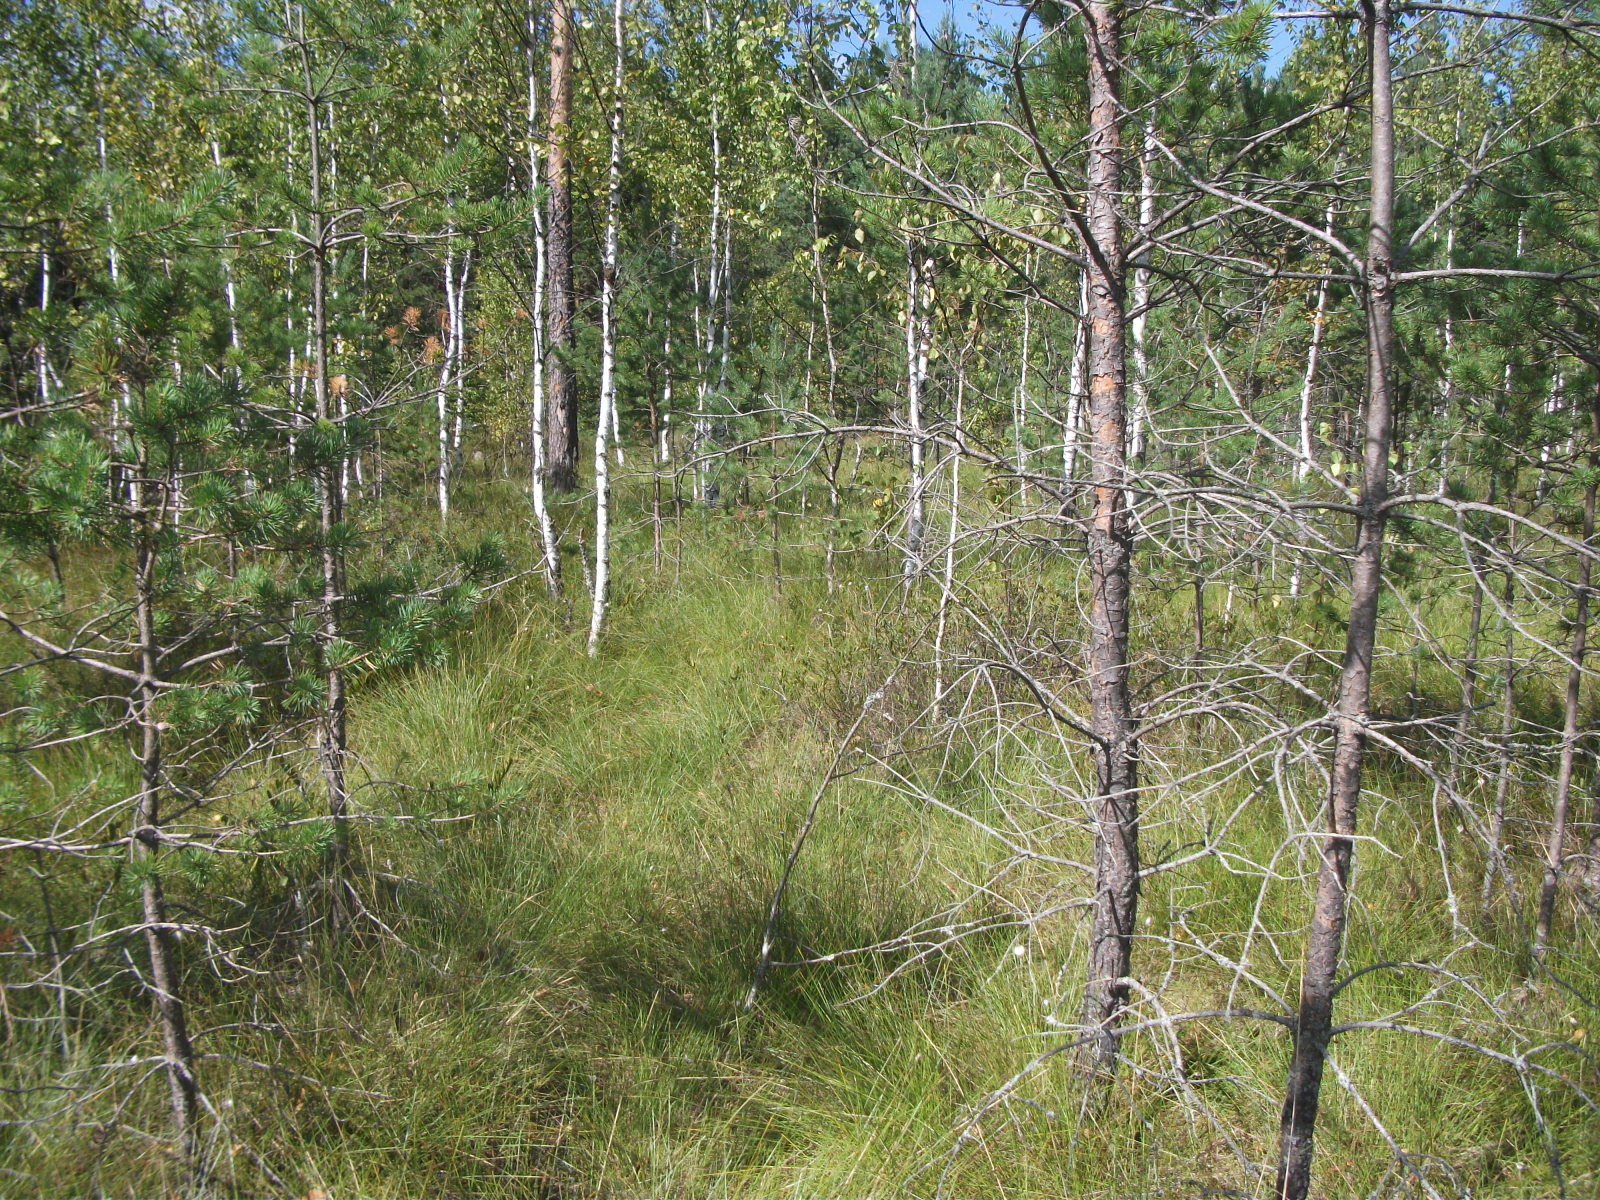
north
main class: Woodland
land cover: Other mixed woodland
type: hemiboreal forest and nemoral coniferous forest and mixed broadleaved-coniferous forest
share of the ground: 25 - 50 %
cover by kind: lichens and mosses 65 %, broadleaved forest trees 25 %, coniferous forest trees 10 %
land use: Semi-natural and natural areas not in use
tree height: < 5 m
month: August
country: LV
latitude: 56.4391
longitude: 26.3133
